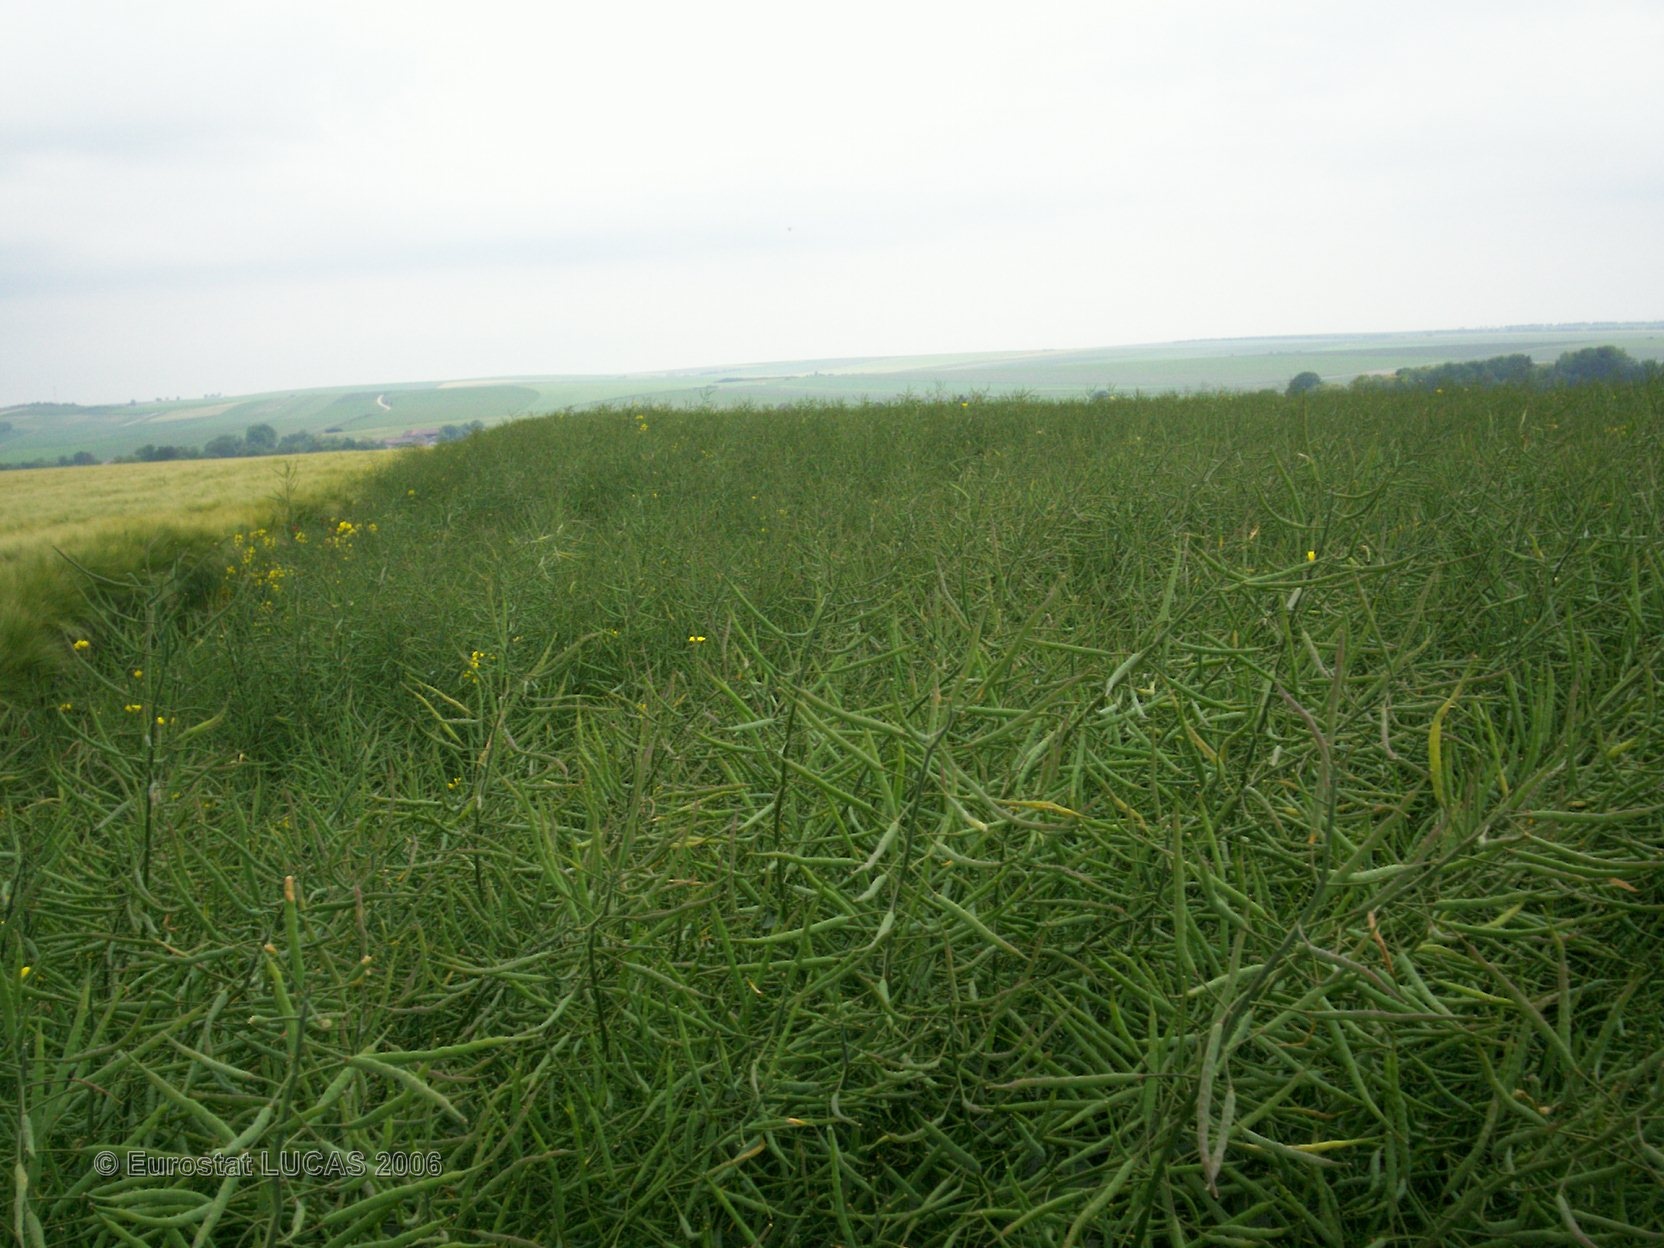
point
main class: Cropland
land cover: Rape and turnip rape
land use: Agriculture (excluding fallow land and kitchen gardens)
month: June
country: FR
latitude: 48.7489
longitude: 4.4069
